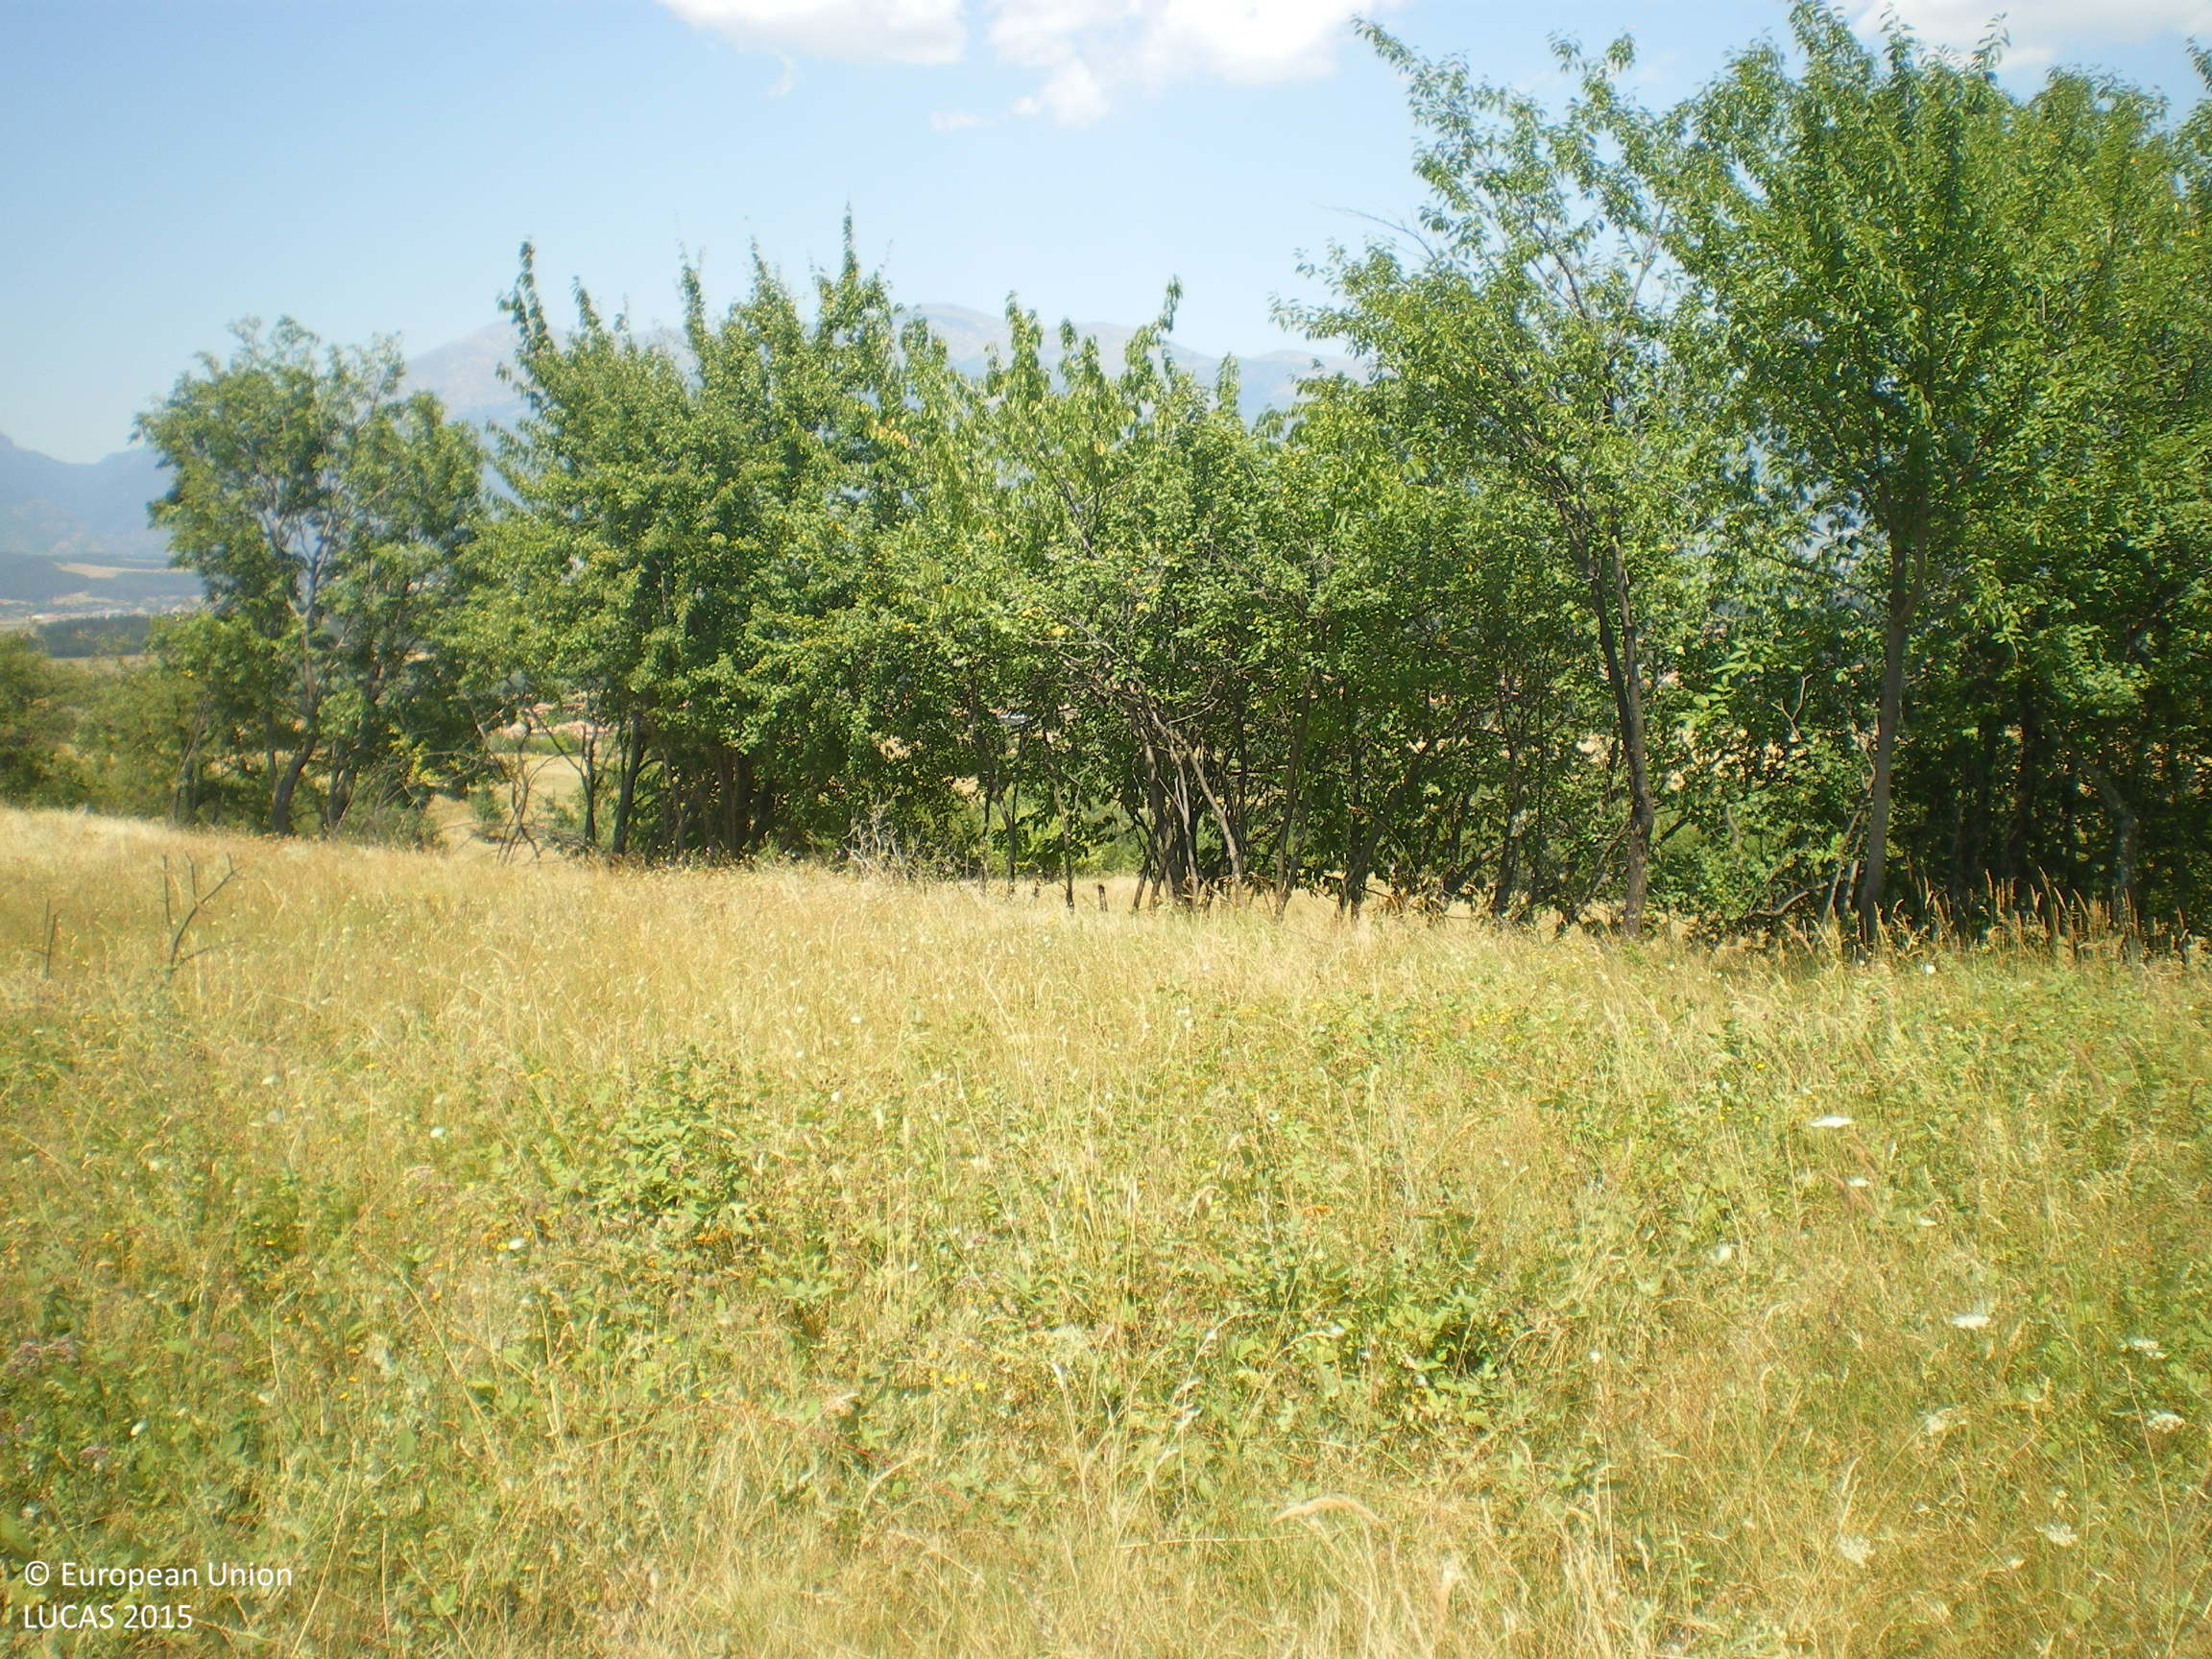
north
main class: Grassland
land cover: Grassland without tree/shrub cover
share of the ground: > 75 %
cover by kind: herbaceous plants 100 %
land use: Agriculture (excluding fallow land and kitchen gardens)
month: July
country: BG
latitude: 42.5802
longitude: 25.0858
